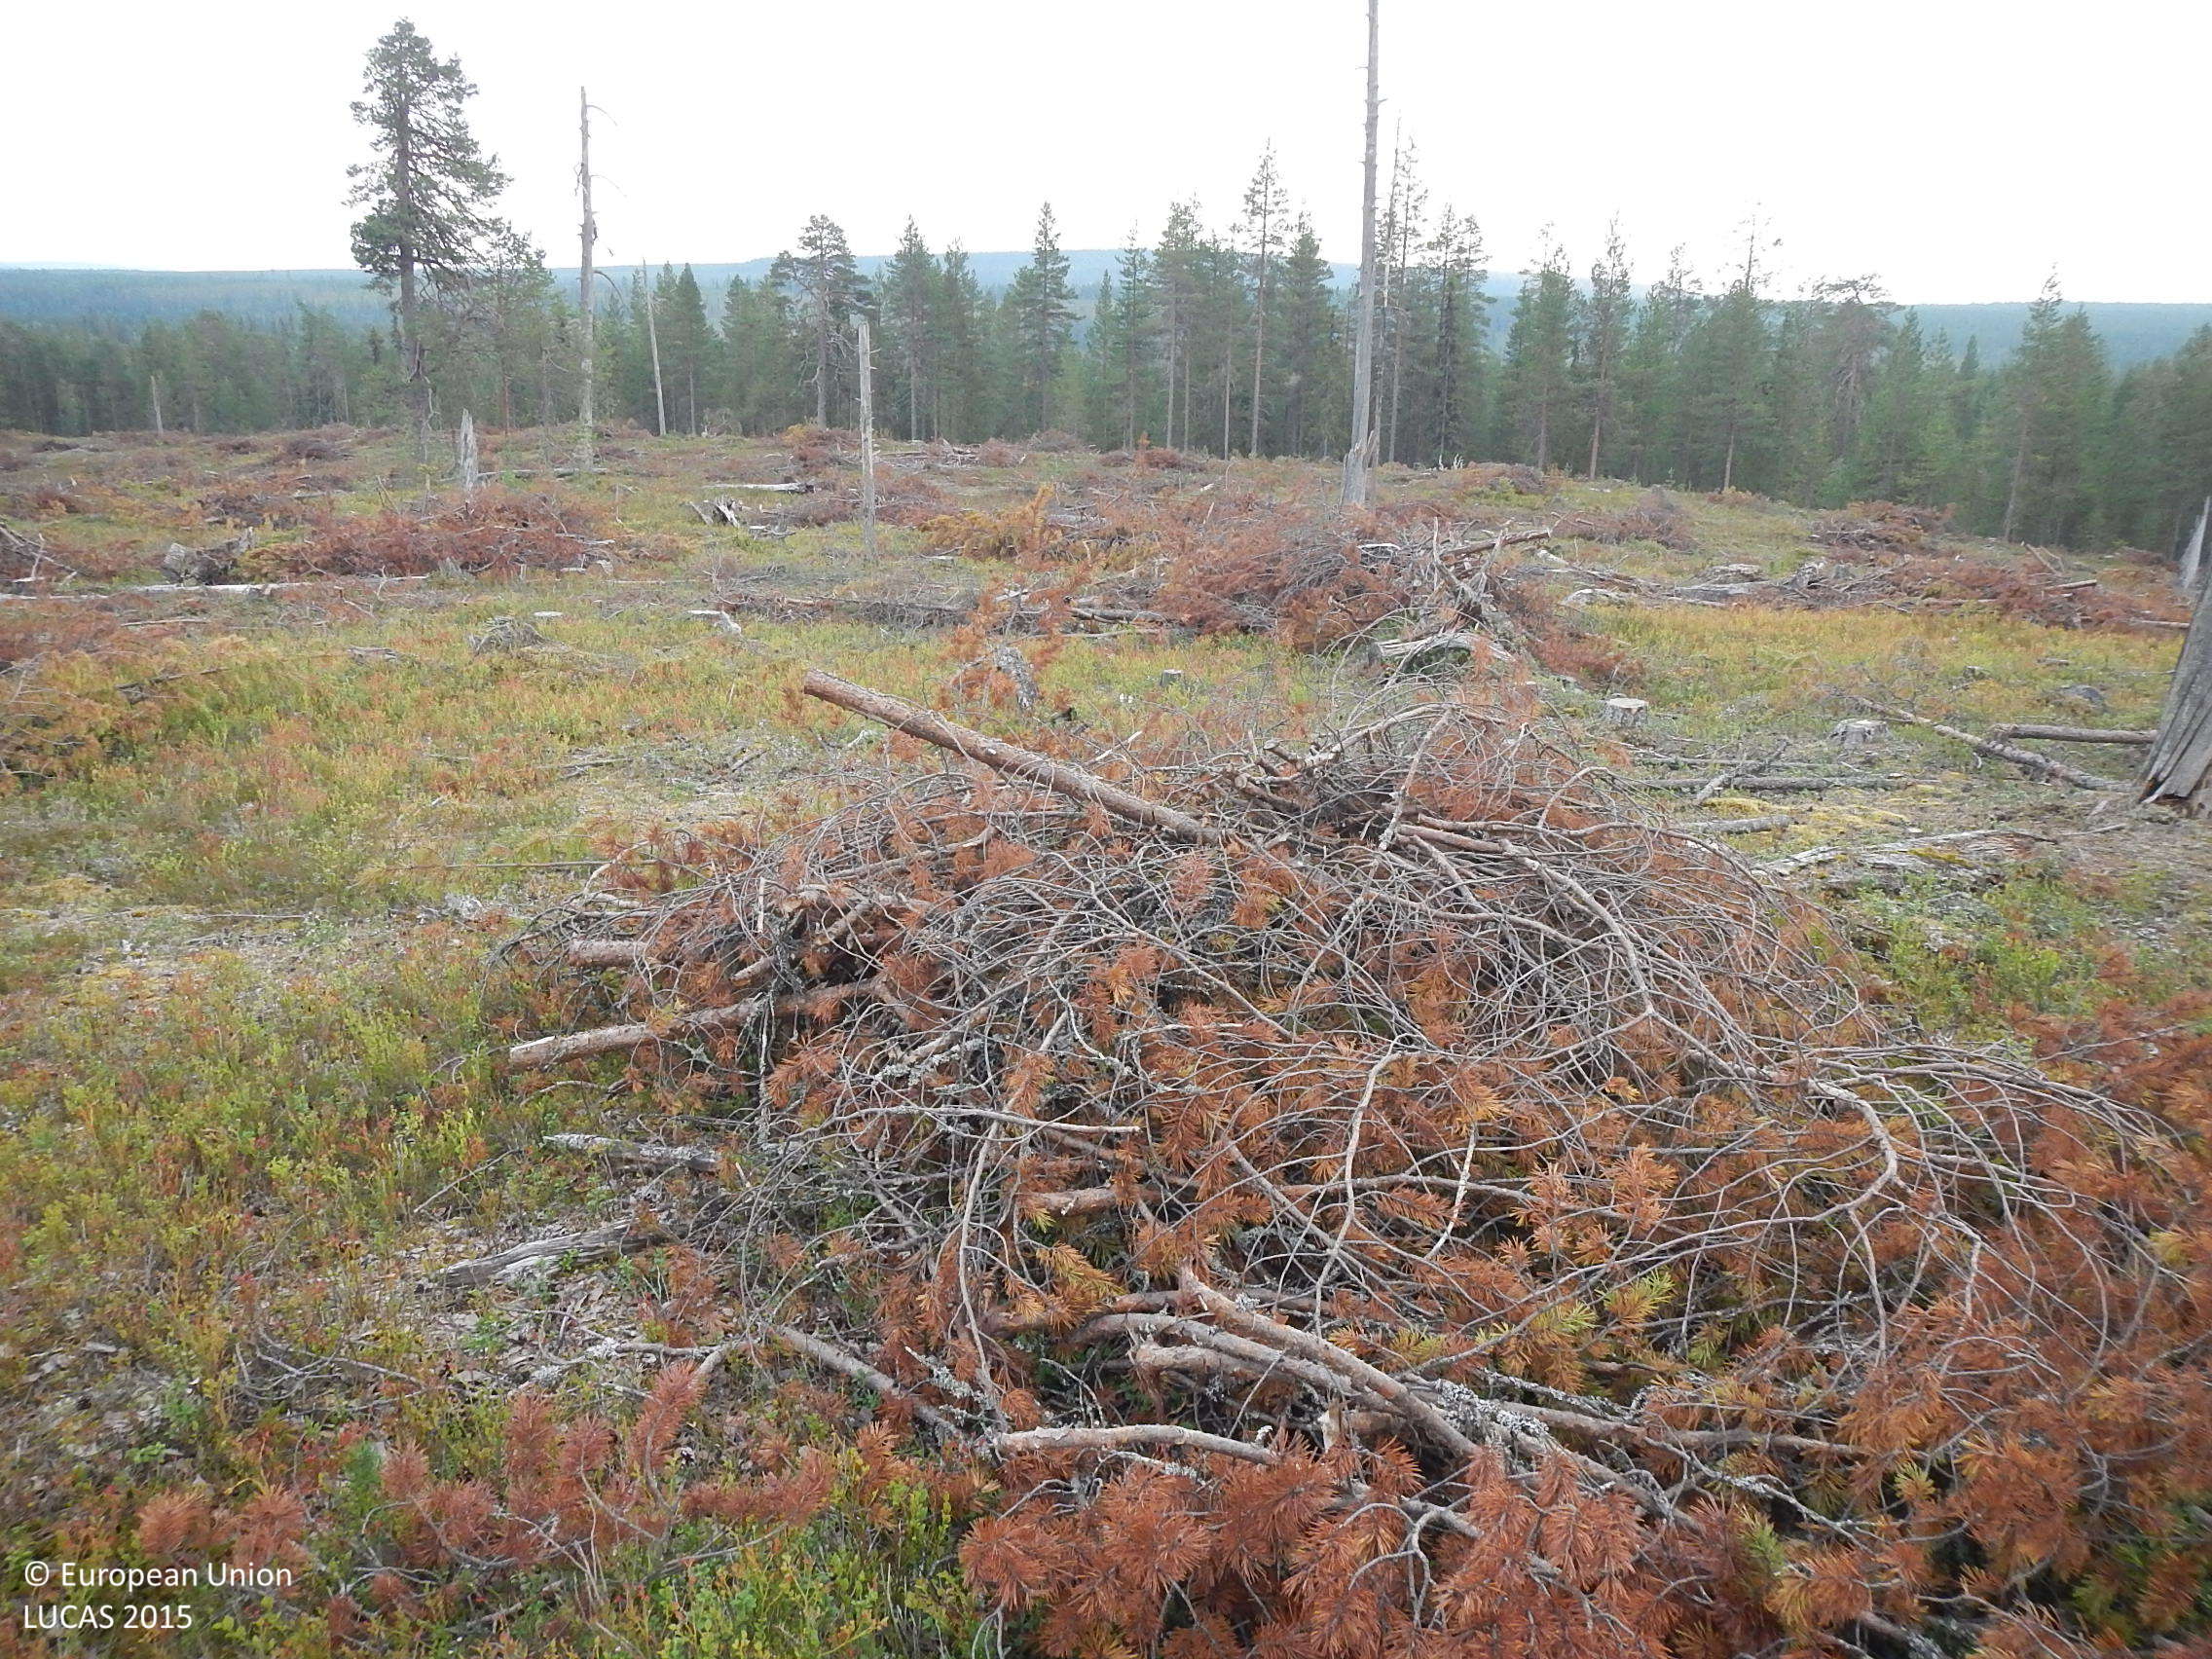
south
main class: Shrubland
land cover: Shrubland with sparse tree cover
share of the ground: > 75 %
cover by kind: shrubs 75 %, lichens and mosses 10 %, unconsolidated bare surface 10 %, coniferous forest trees 5 %
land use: Forestry
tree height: < 5 m
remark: Clear cut
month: August
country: FI
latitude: 66.0571
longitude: 27.8645
